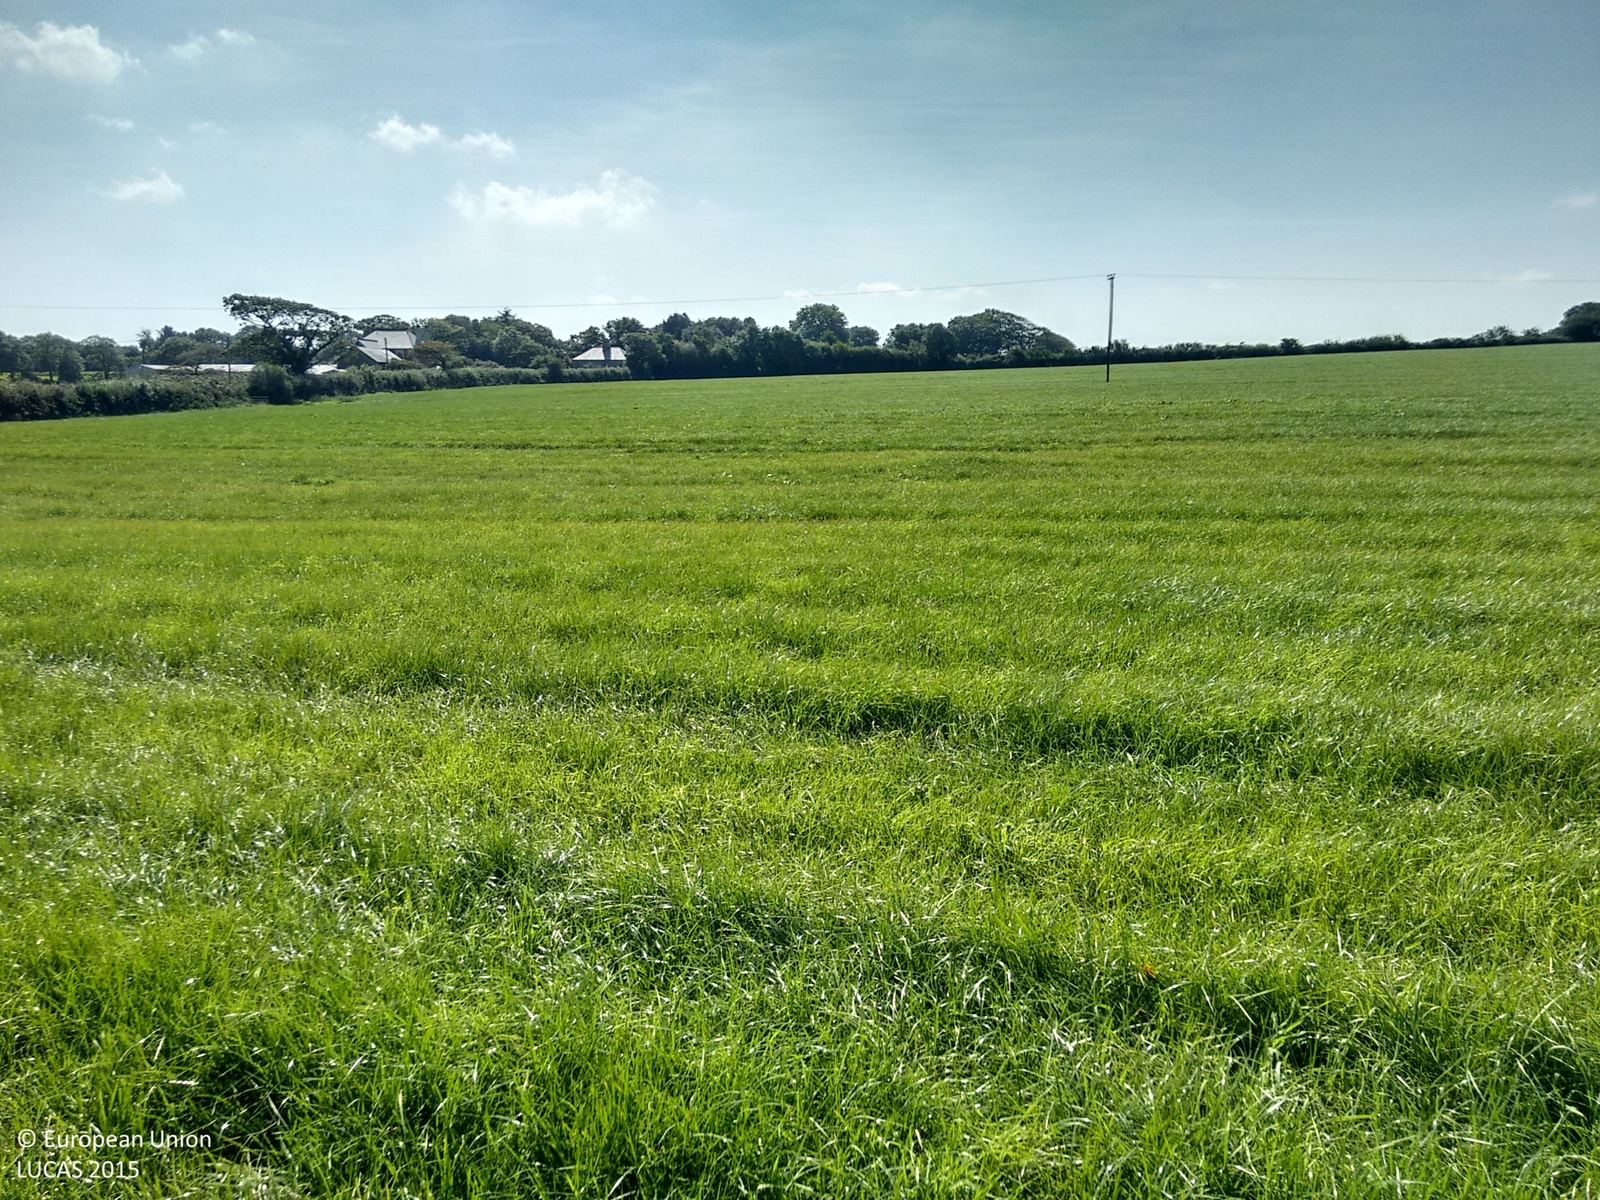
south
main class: Cropland
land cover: Temporary grasslands
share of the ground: > 75 %
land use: Agriculture (excluding fallow land and kitchen gardens)
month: September
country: GB
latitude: 50.8596
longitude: -4.2058
